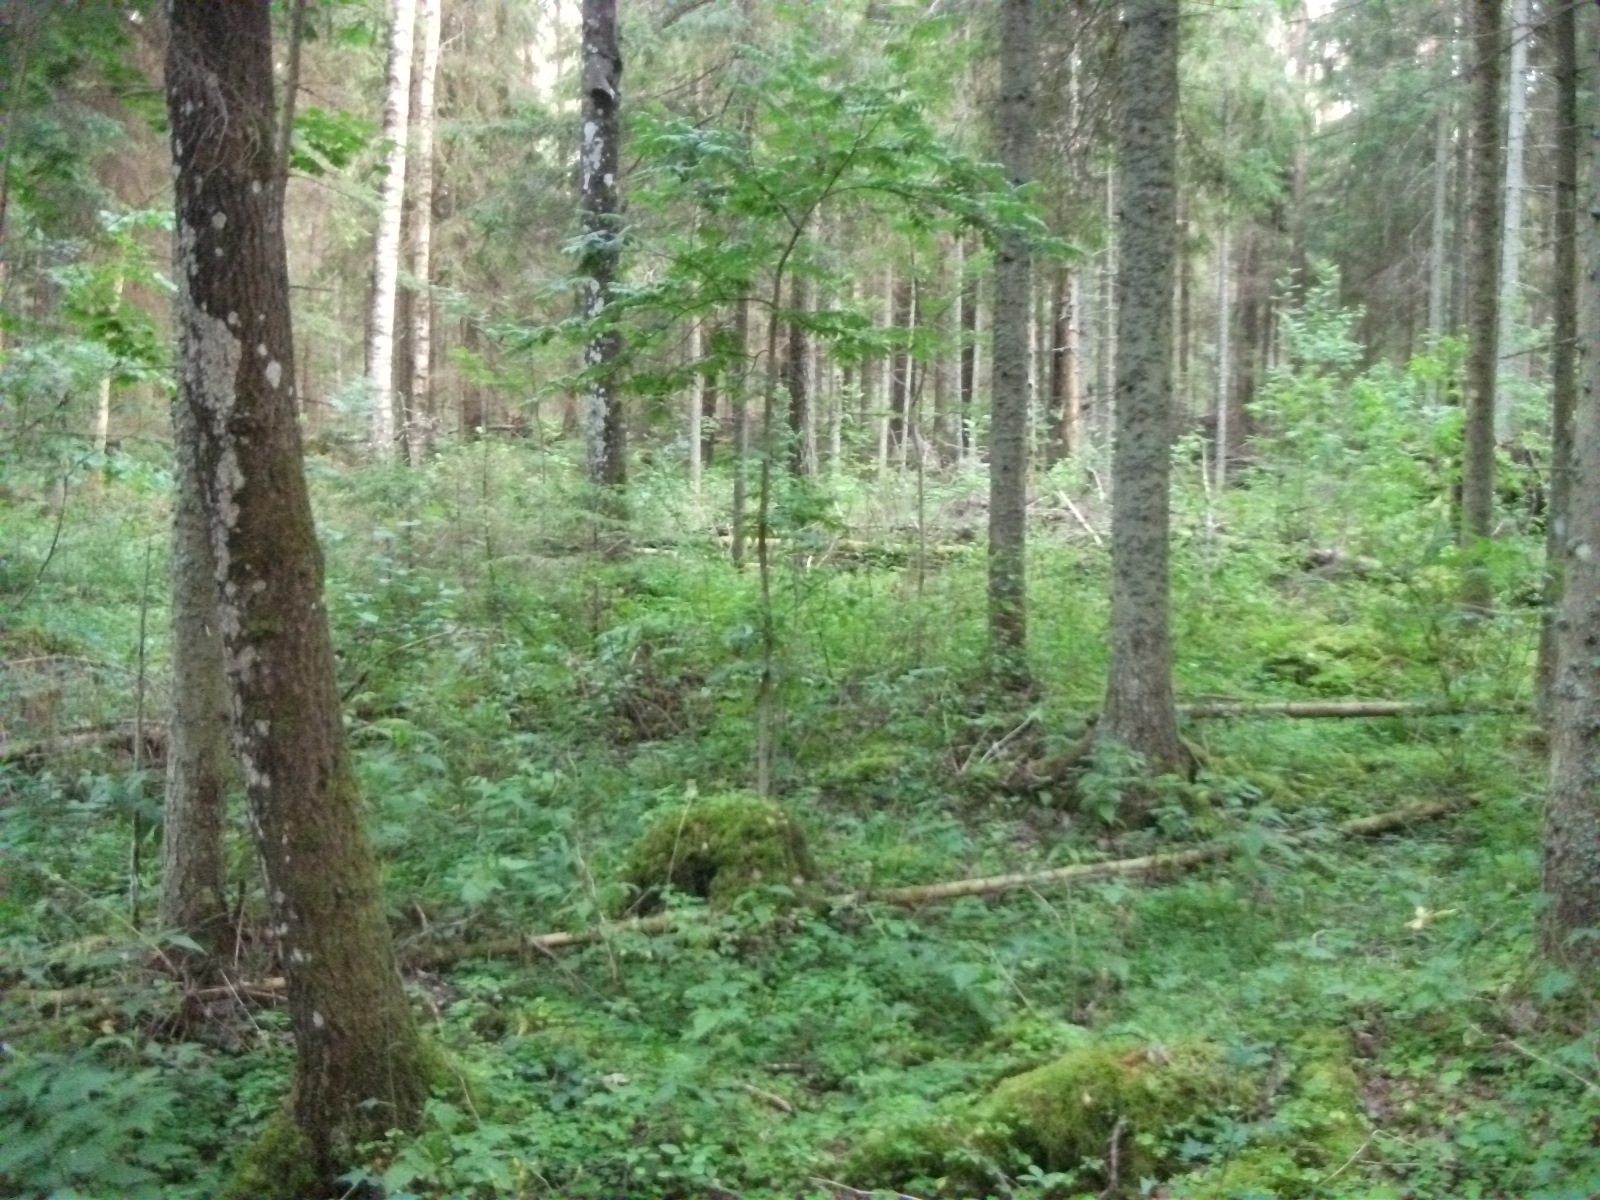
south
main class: Woodland
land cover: Spruce dominated mixed woodland
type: hemiboreal forest and nemoral coniferous forest and mixed broadleaved-coniferous forest
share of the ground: > 75 %
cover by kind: coniferous forest trees 60 %, broadleaved forest trees 25 %, shrubs 5 %, herbaceous plants 5 %, lichens and mosses 5 %
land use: Forestry
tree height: > 5 m
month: July
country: LV
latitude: 57.1382
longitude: 26.3163
